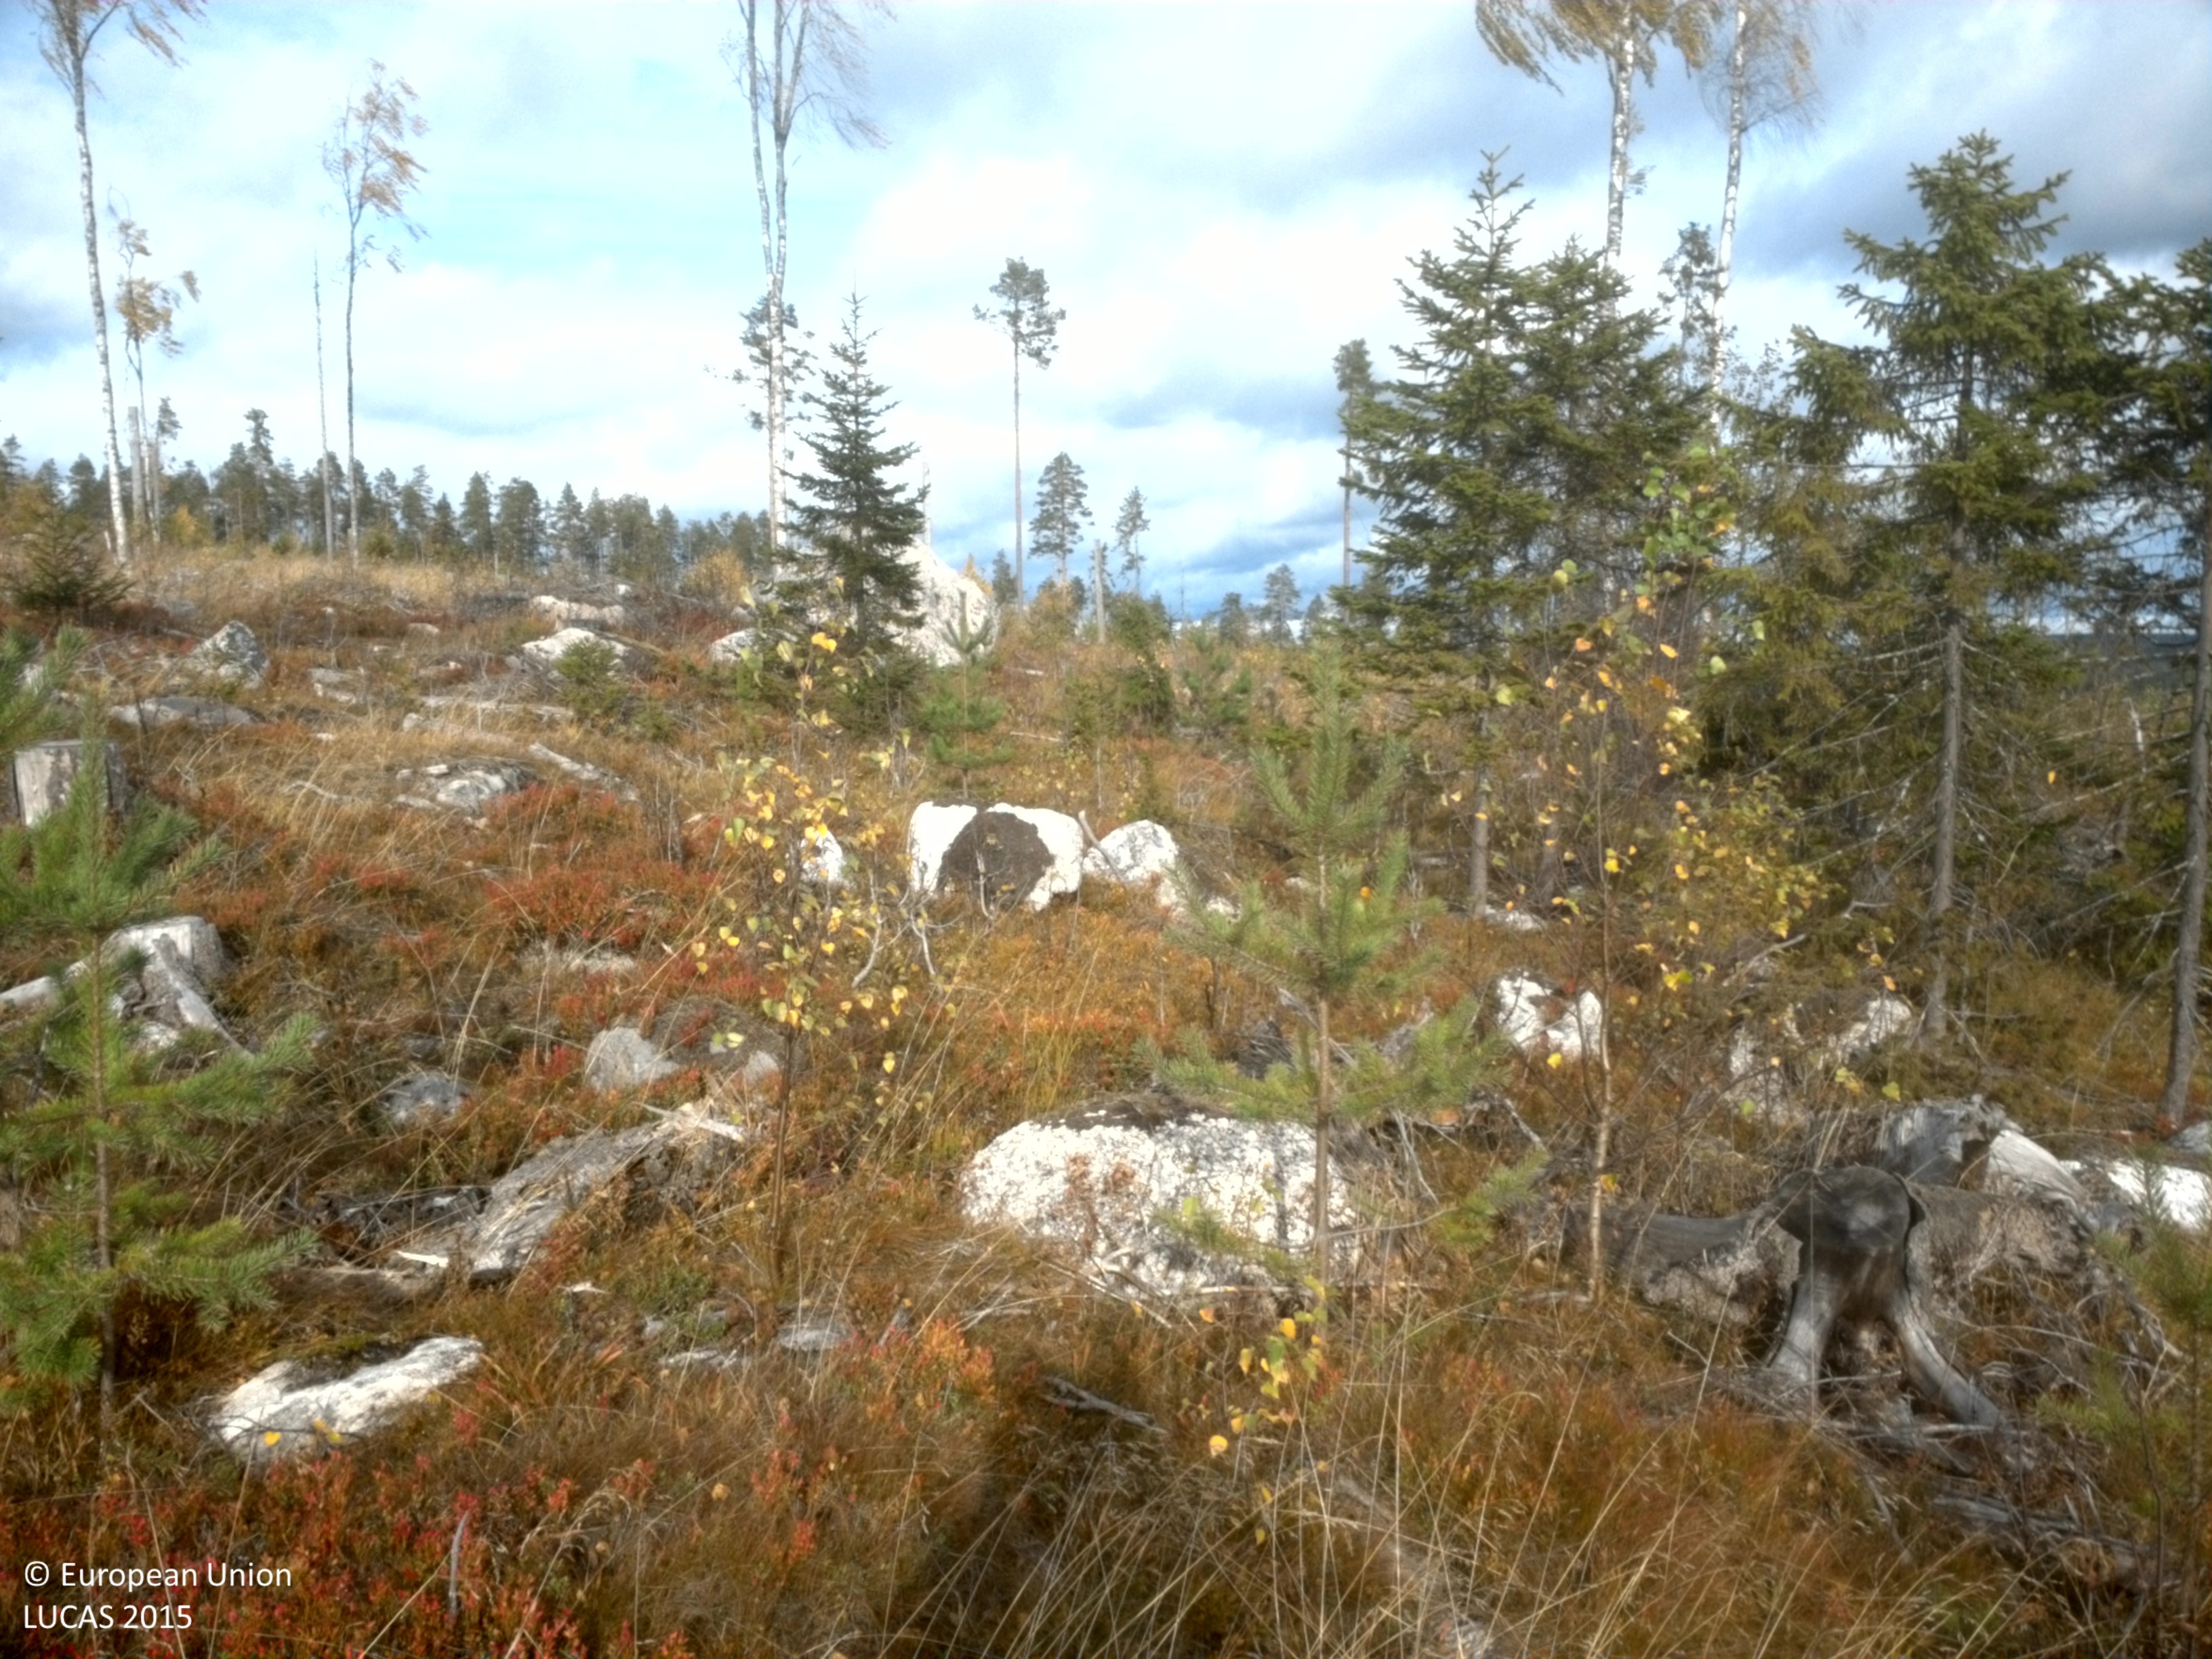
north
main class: Woodland
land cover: Broadleaved woodland
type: boreal forest
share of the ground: 50 - 75 %
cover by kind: broadleaved forest trees 45 %, herbaceous plants 40 %, shrubs 10 %, coniferous forest trees 5 %
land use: Forestry
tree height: < 5 m
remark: Clear cut
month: October
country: SE
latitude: 64.0560
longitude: 20.1198
